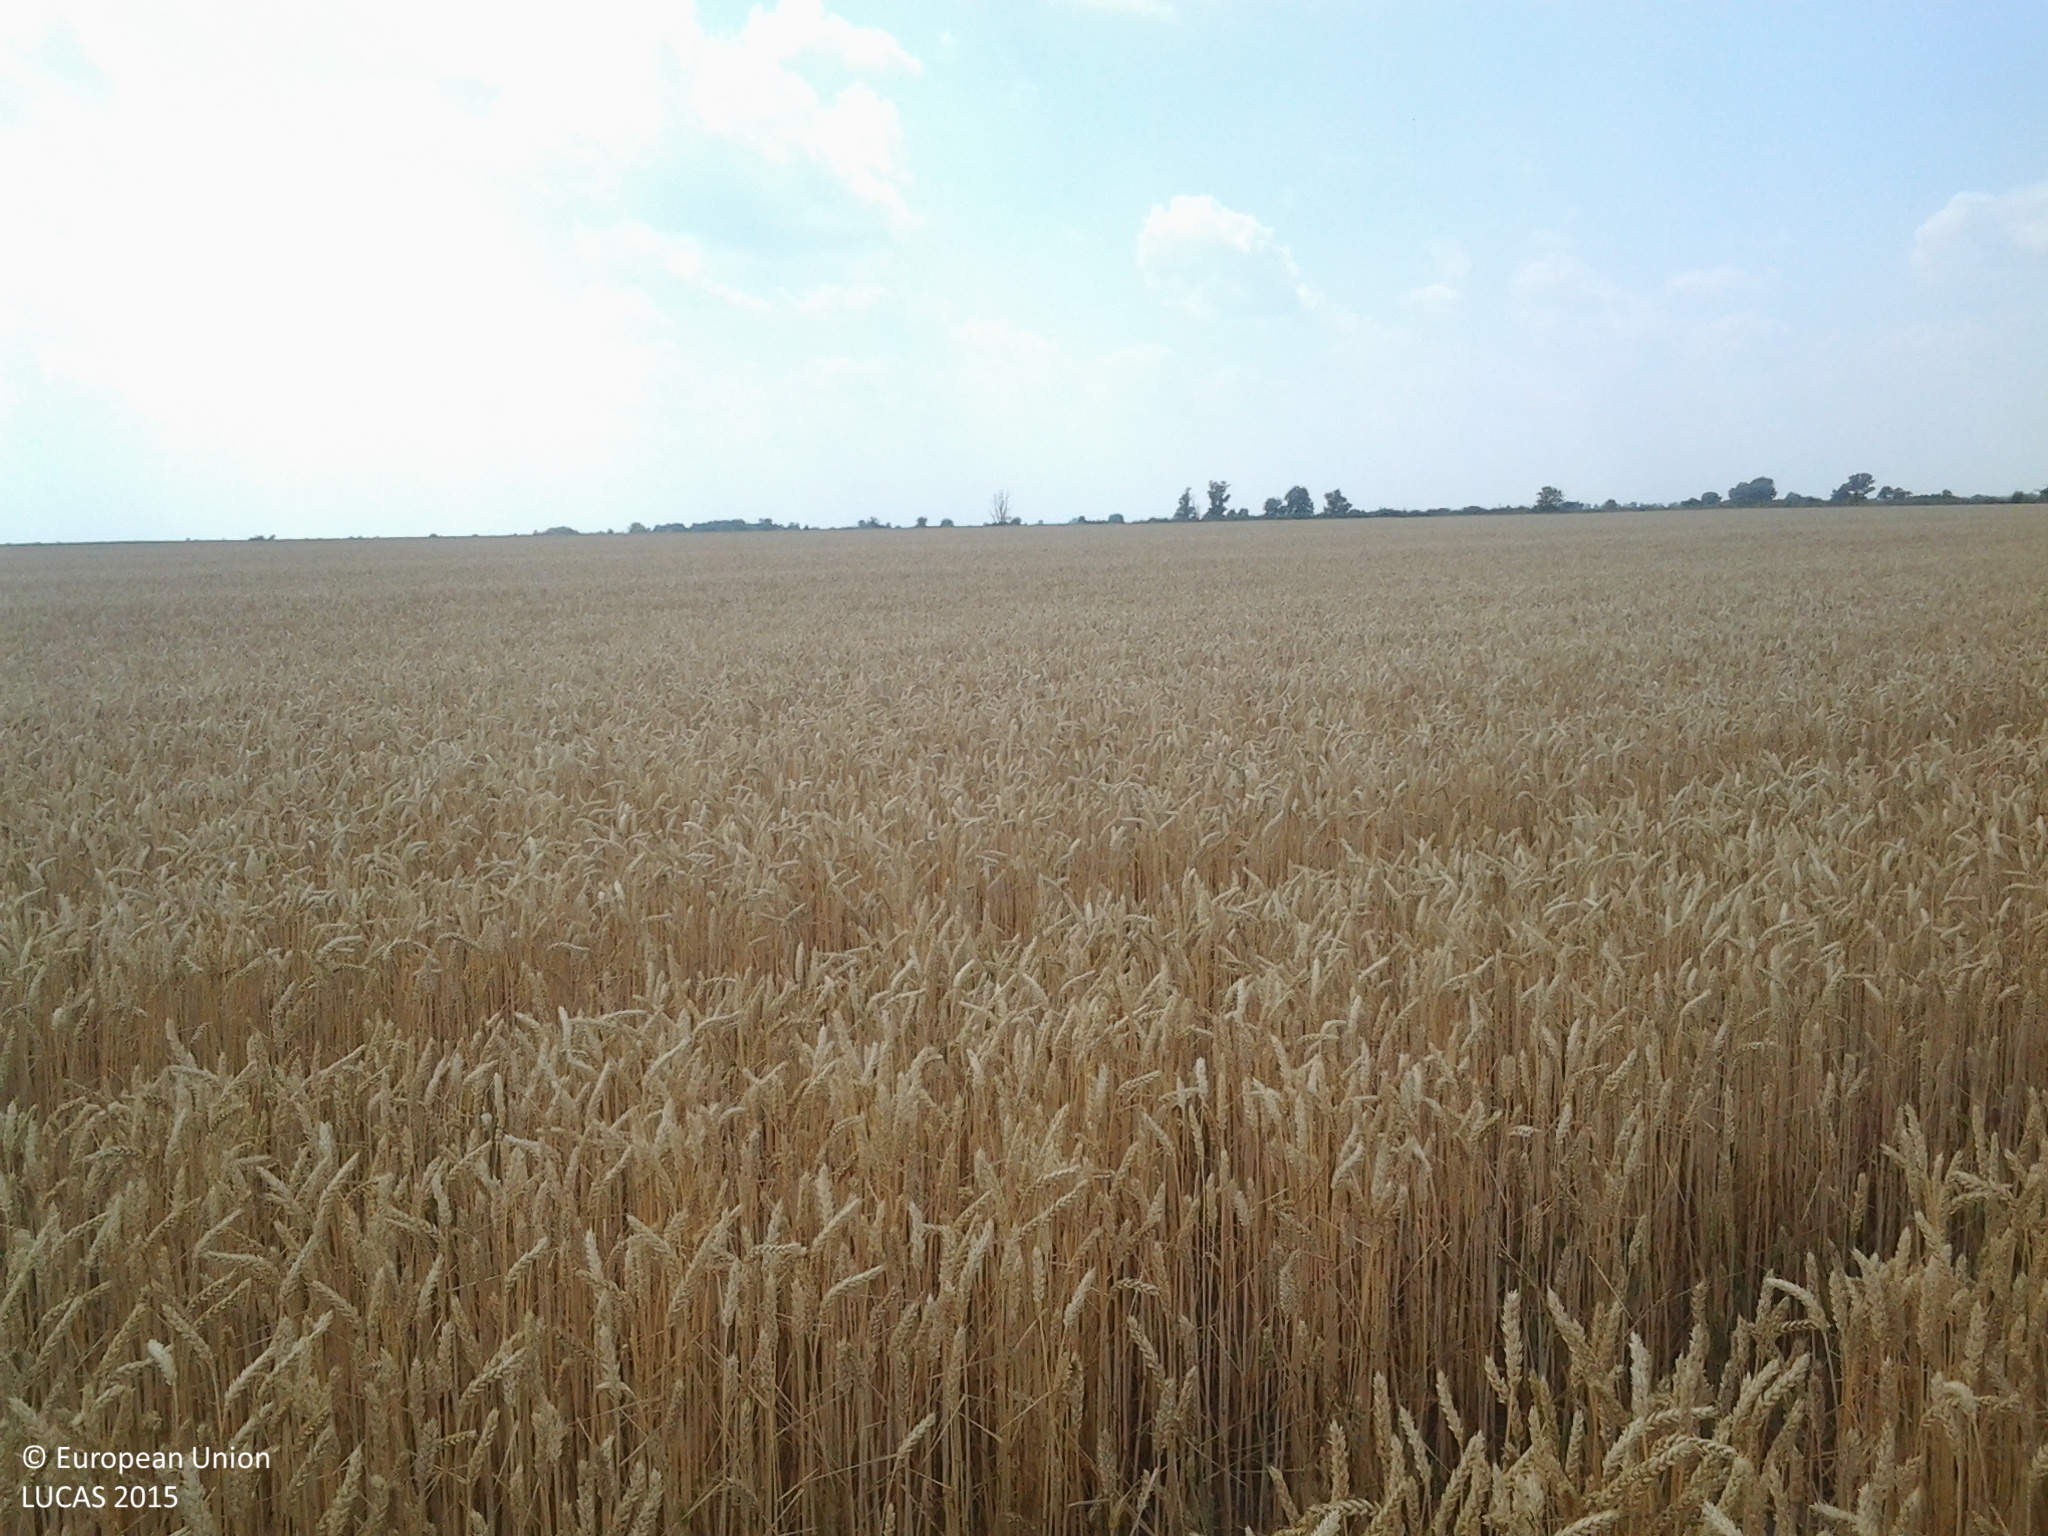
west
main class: Cropland
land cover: Common wheat
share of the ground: > 75 %
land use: Agriculture (excluding fallow land and kitchen gardens)
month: July
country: HU
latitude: 47.0933
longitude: 19.2263
